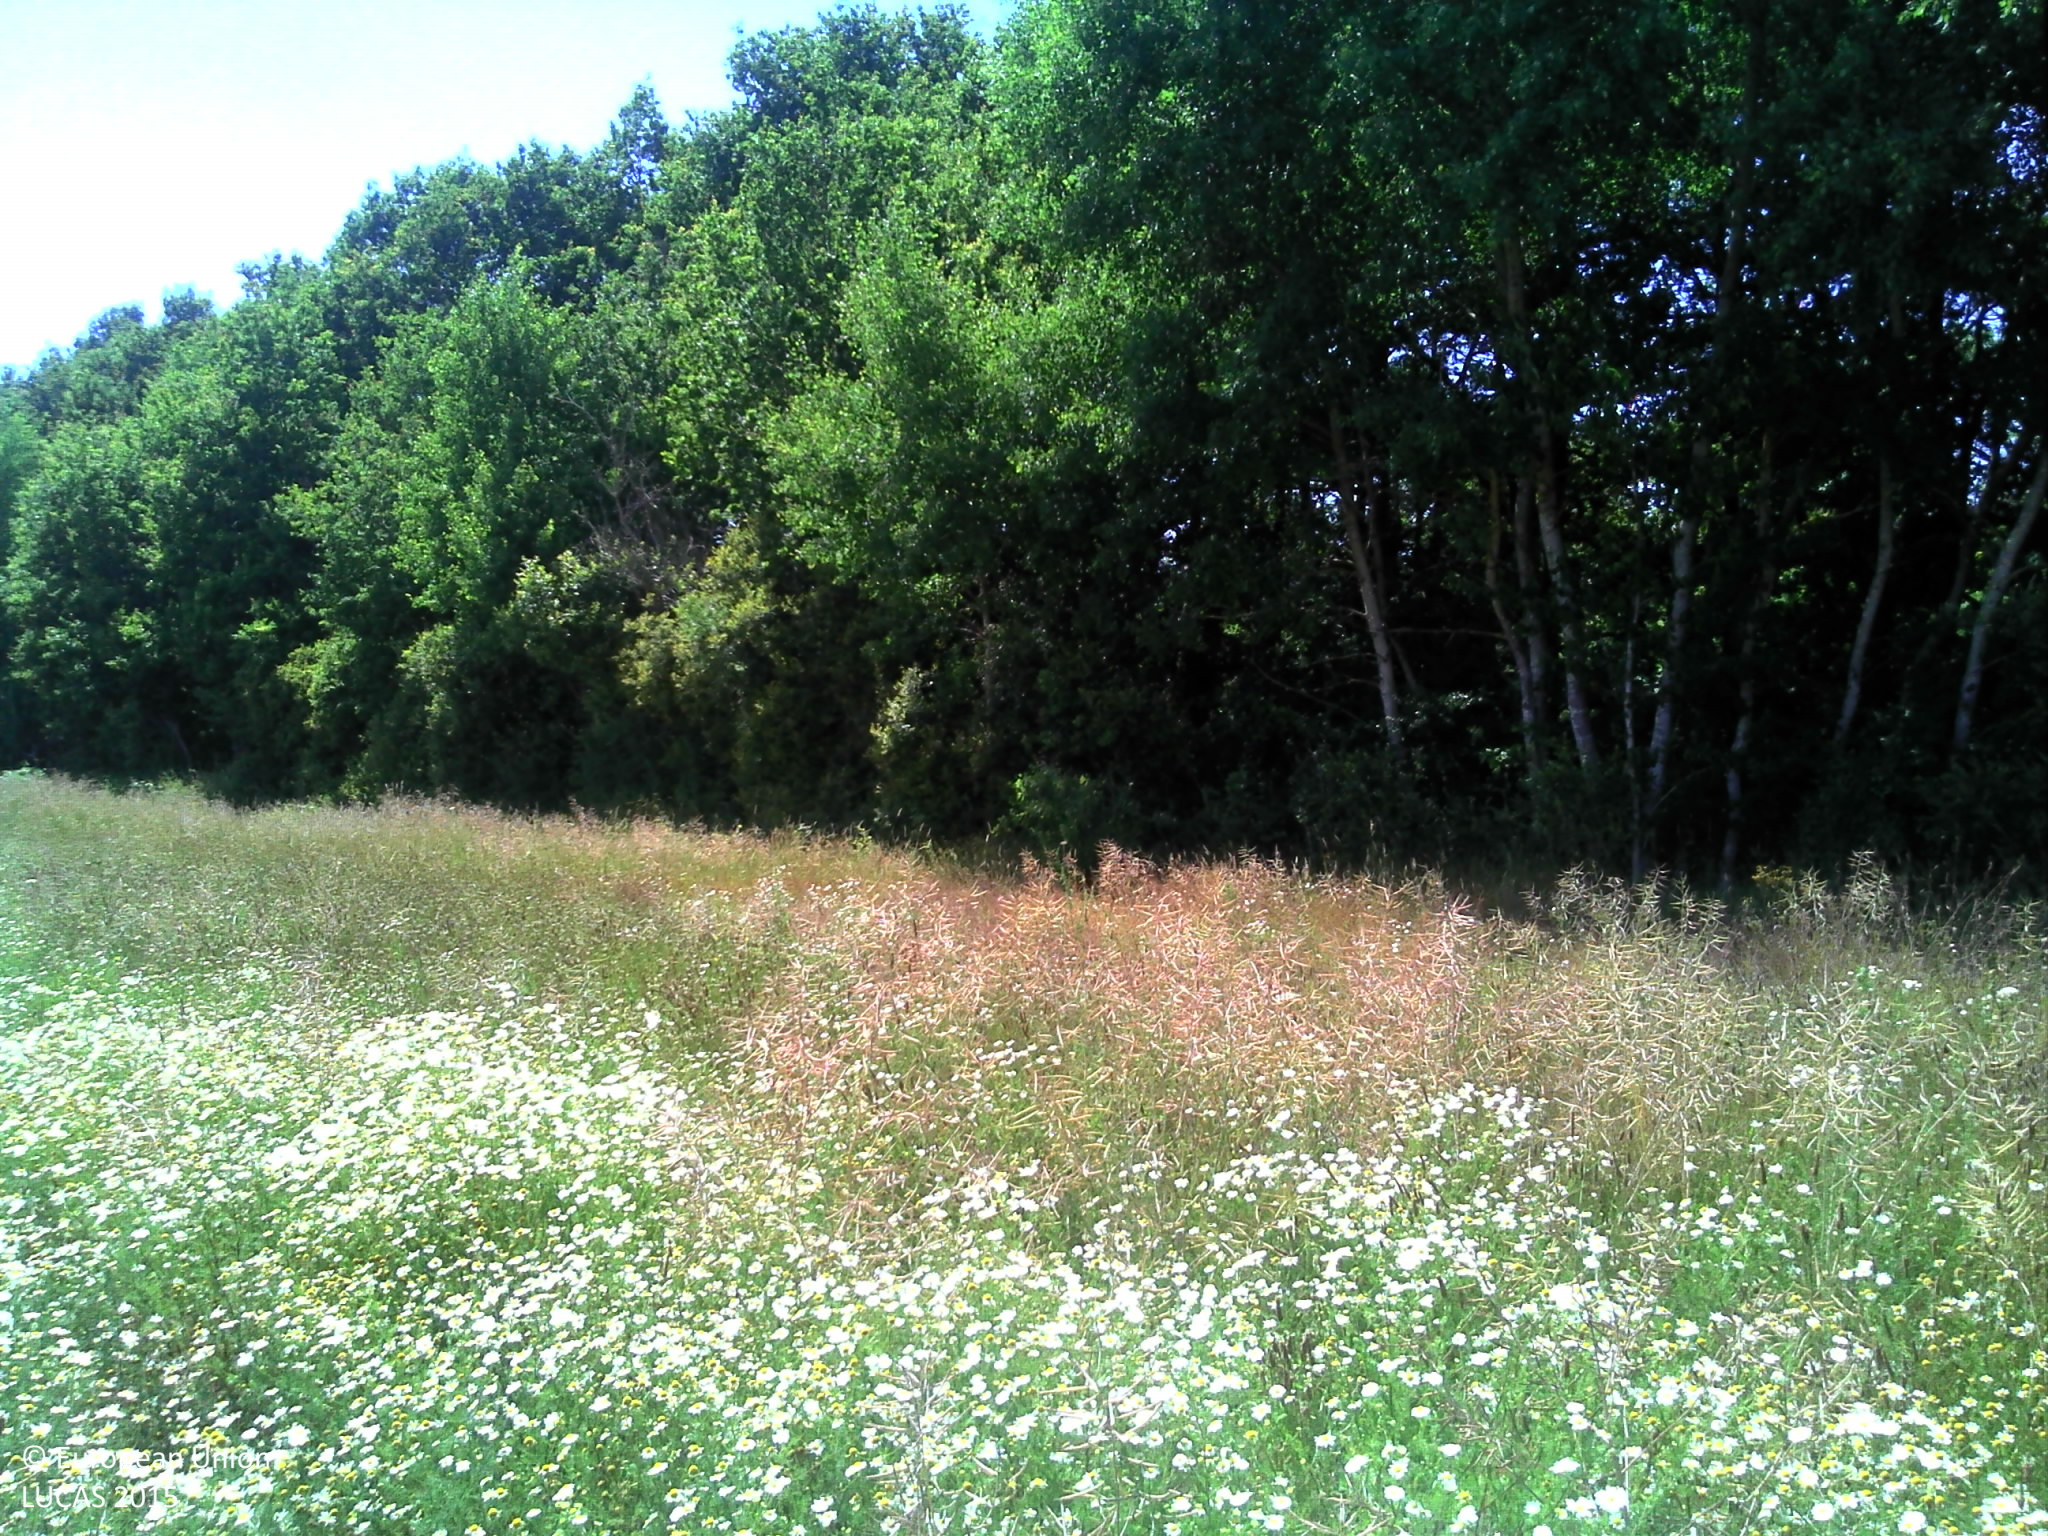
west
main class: Cropland
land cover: Rape and turnip rape
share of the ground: > 75 %
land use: Agriculture (excluding fallow land and kitchen gardens)
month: June
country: FR
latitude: 47.5905
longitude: 2.5317
